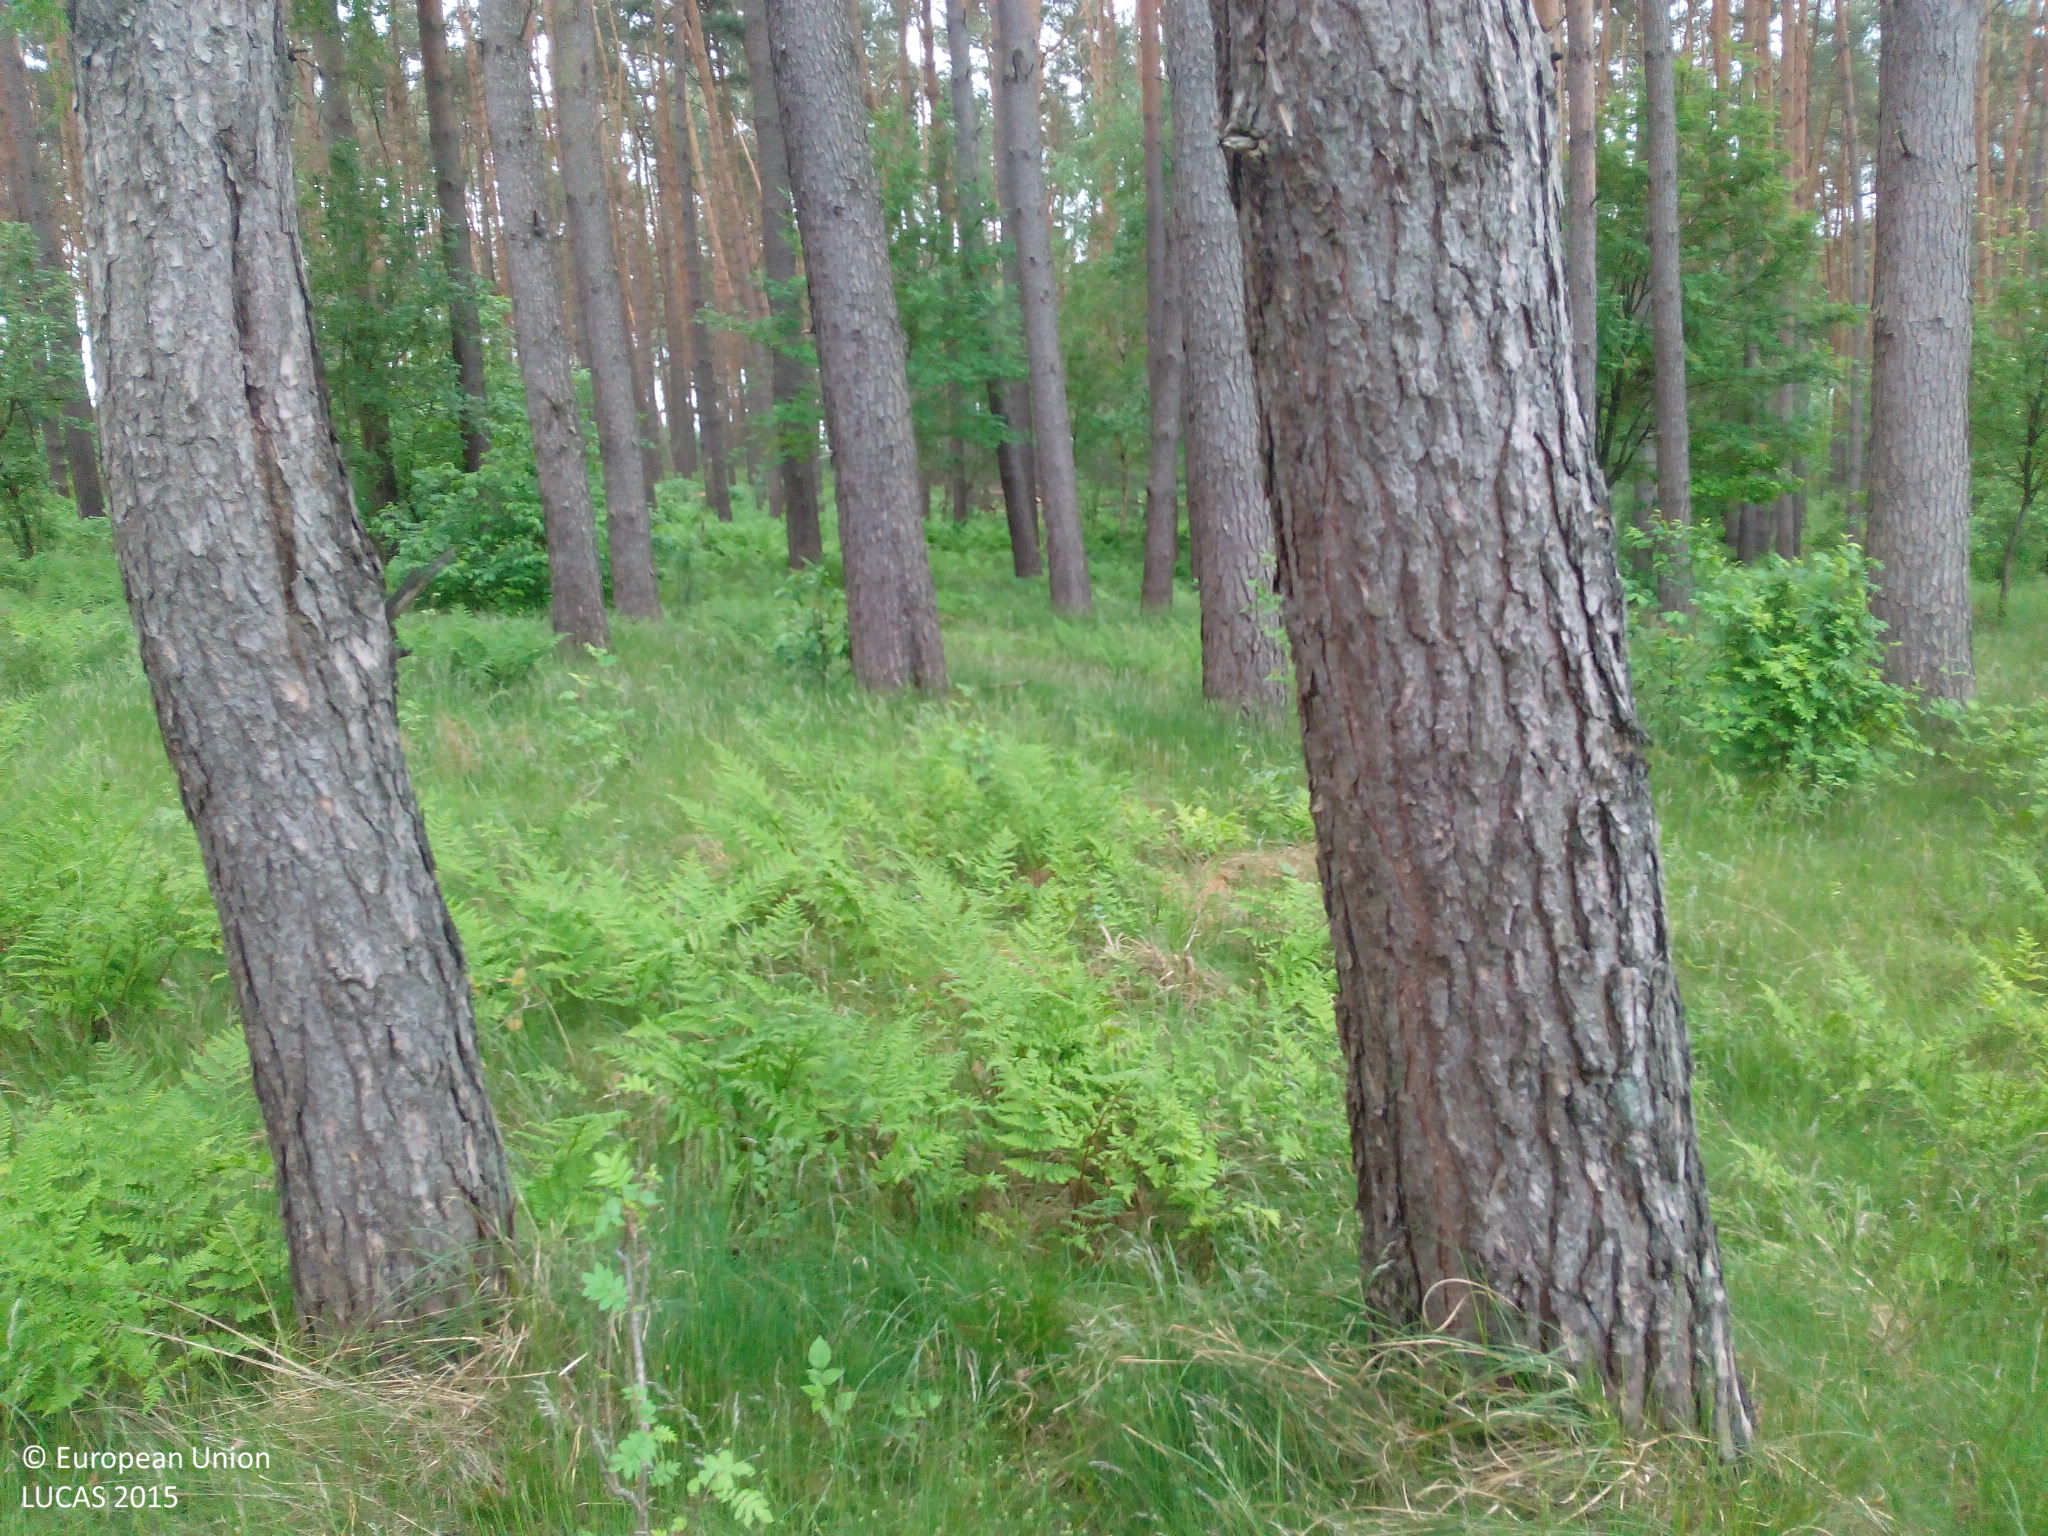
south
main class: Woodland
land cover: Pine dominated coniferous woodland
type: hemiboreal forest and nemoral coniferous forest and mixed broadleaved-coniferous forest
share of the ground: > 75 %
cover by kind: coniferous forest trees 85 %, herbaceous plants 10 %, shrubs 5 %
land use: Forestry
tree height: > 5 m
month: June
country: DE
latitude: 53.3010
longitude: 11.6349
